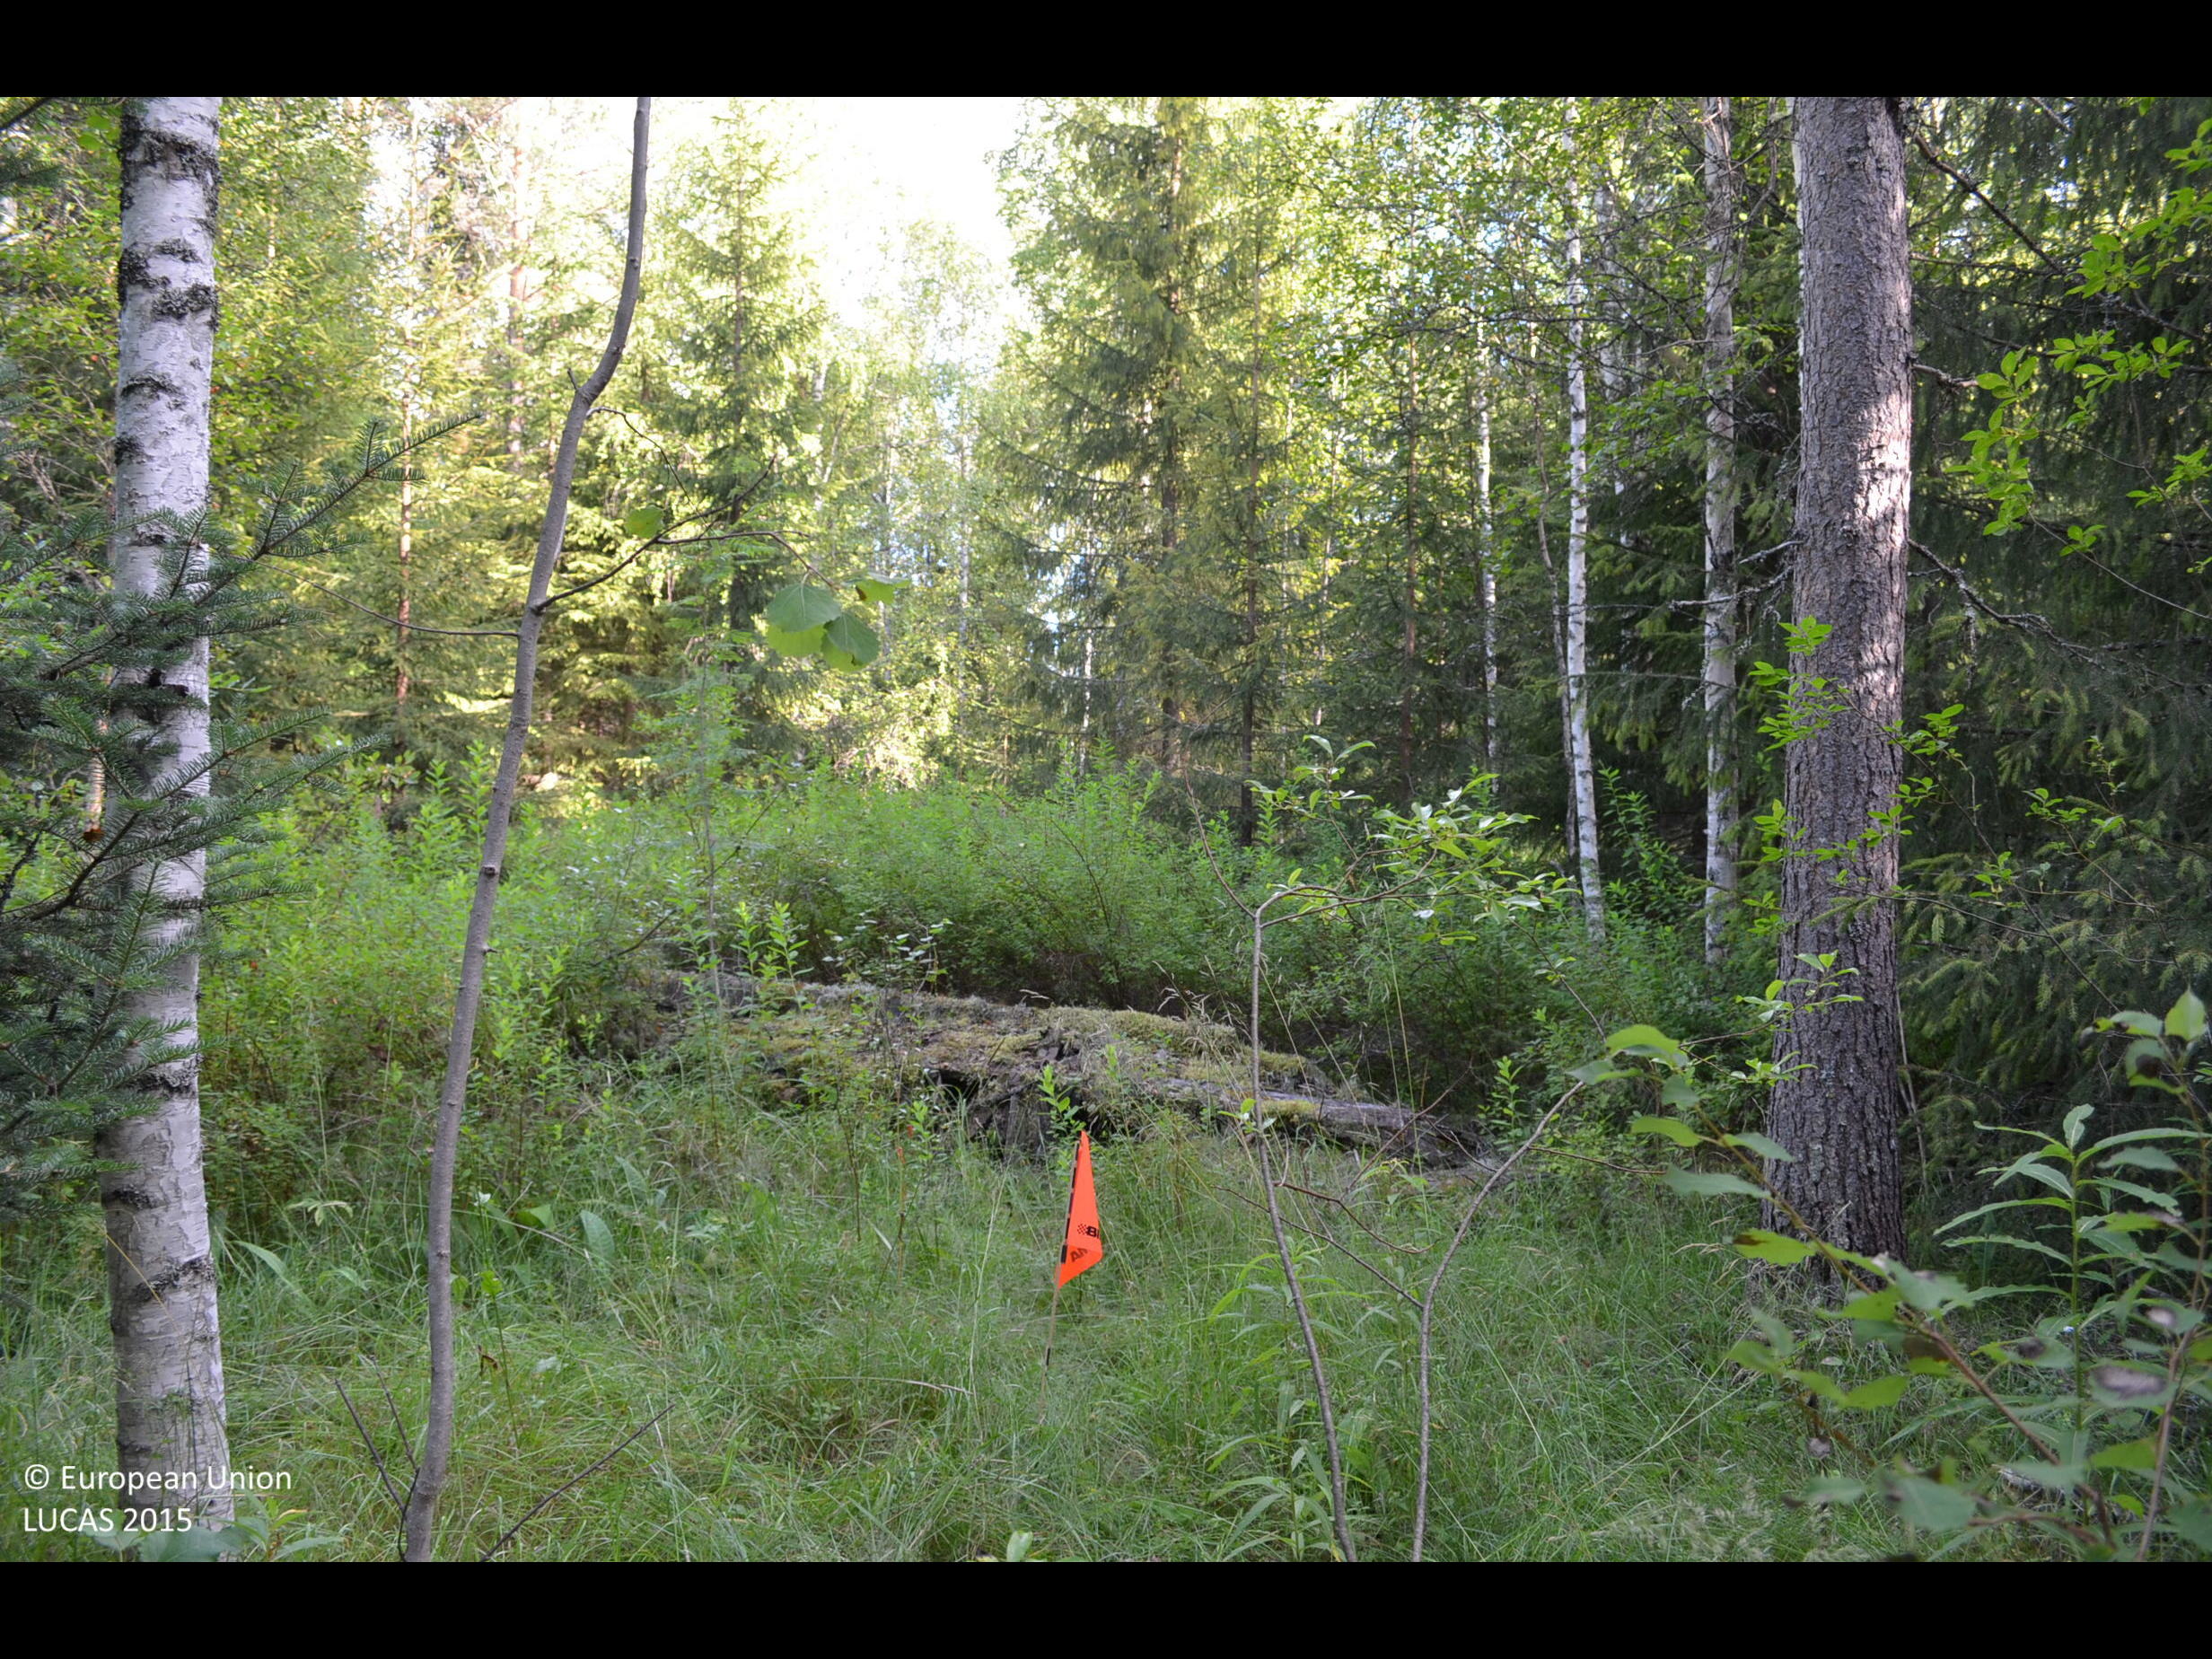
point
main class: Woodland
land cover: Spruce dominated mixed woodland
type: boreal forest
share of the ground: 50 - 75 %
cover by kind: coniferous forest trees 30 %, broadleaved forest trees 30 %, shrubs 25 %, herbaceous plants 15 %
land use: Forestry
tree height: > 5 m
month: August
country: FI
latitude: 62.3383
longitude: 24.3964
